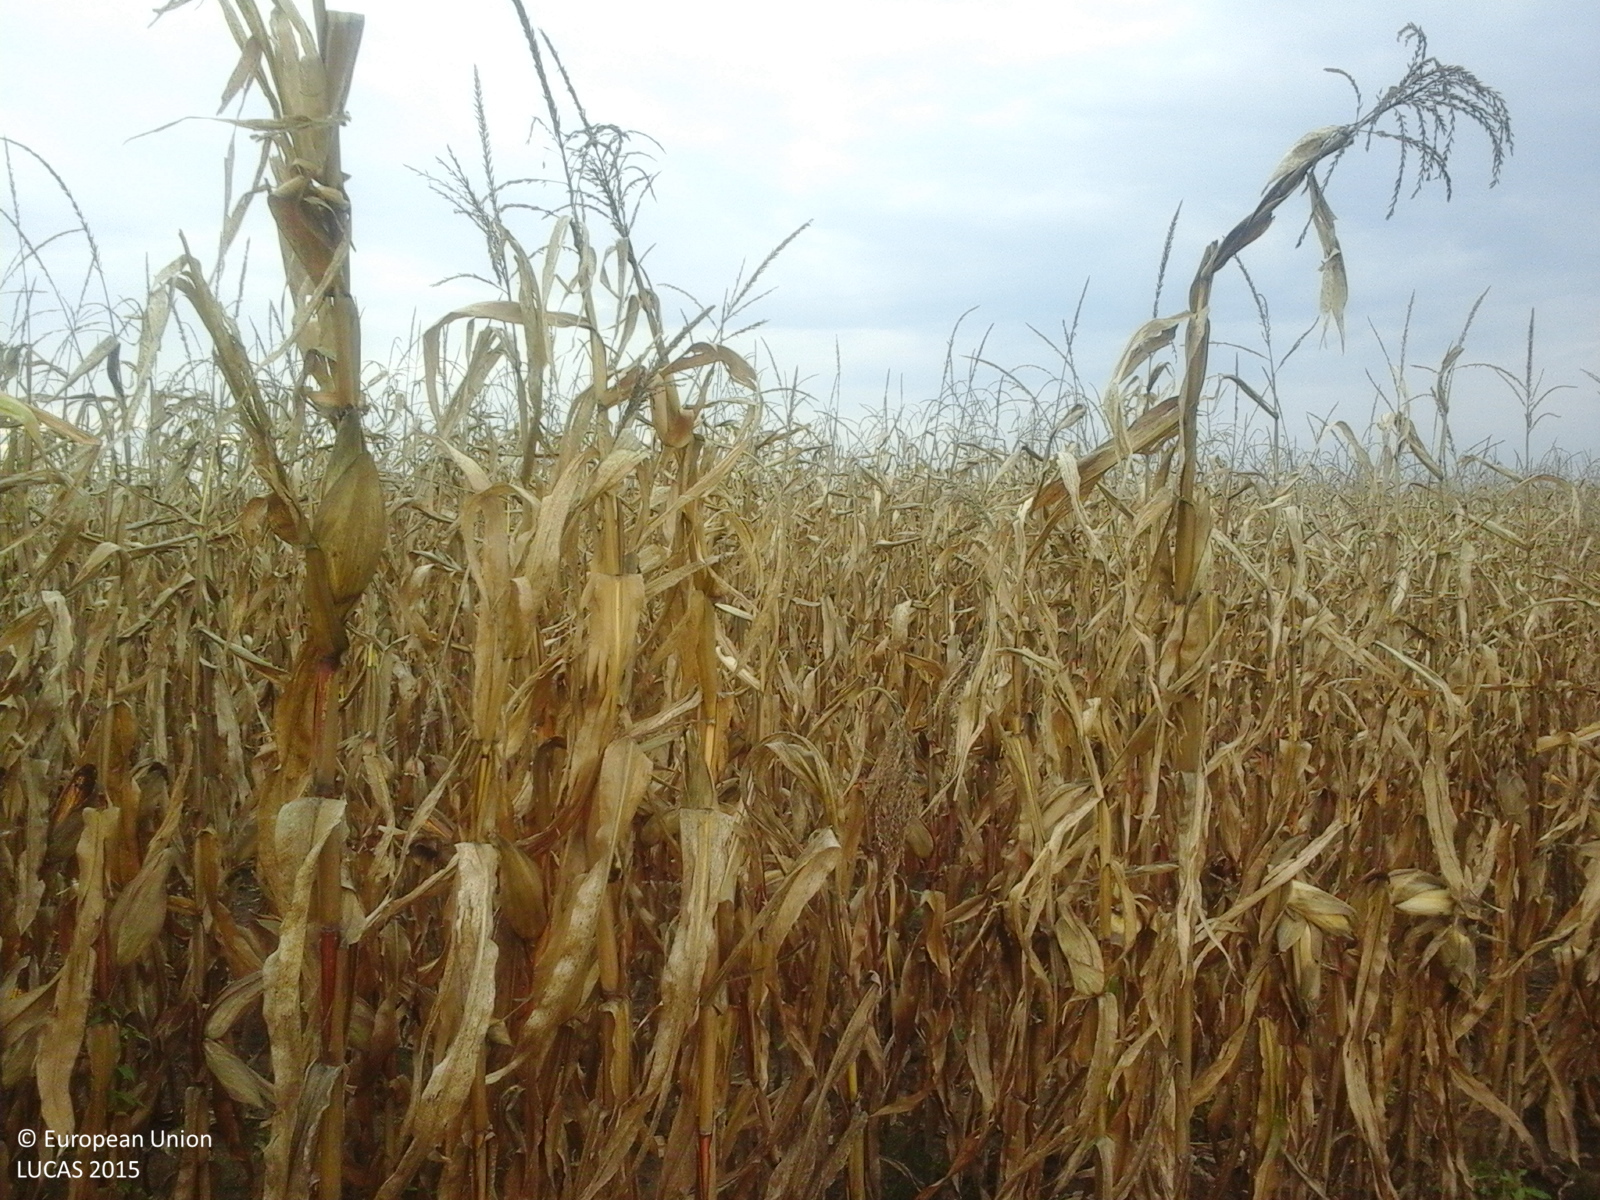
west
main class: Cropland
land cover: Maize
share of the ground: > 75 %
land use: Agriculture (excluding fallow land and kitchen gardens)
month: October
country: RO
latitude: 46.4313
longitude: 23.9880
